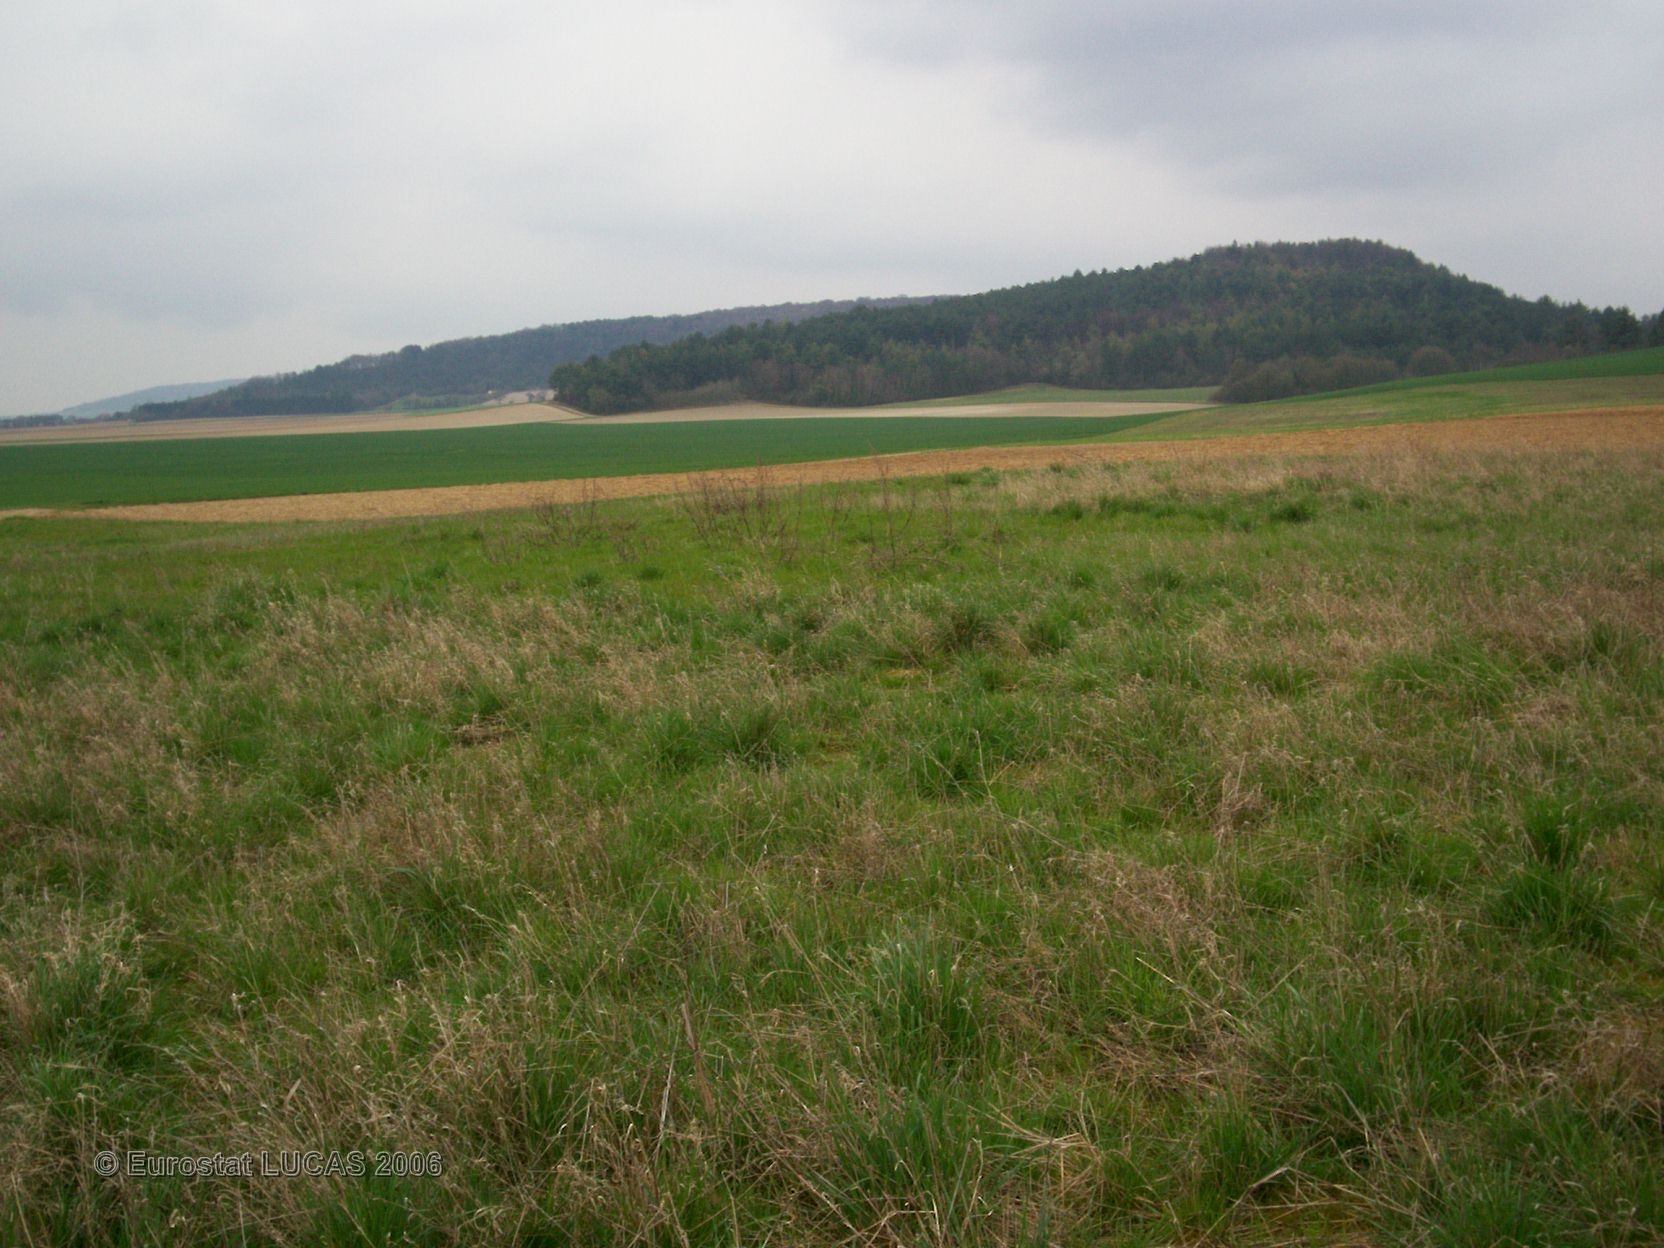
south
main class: Grassland
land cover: Grassland without tree/shrub cover
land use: Fallow land
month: April
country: FR
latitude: 48.2214
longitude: 3.9795
